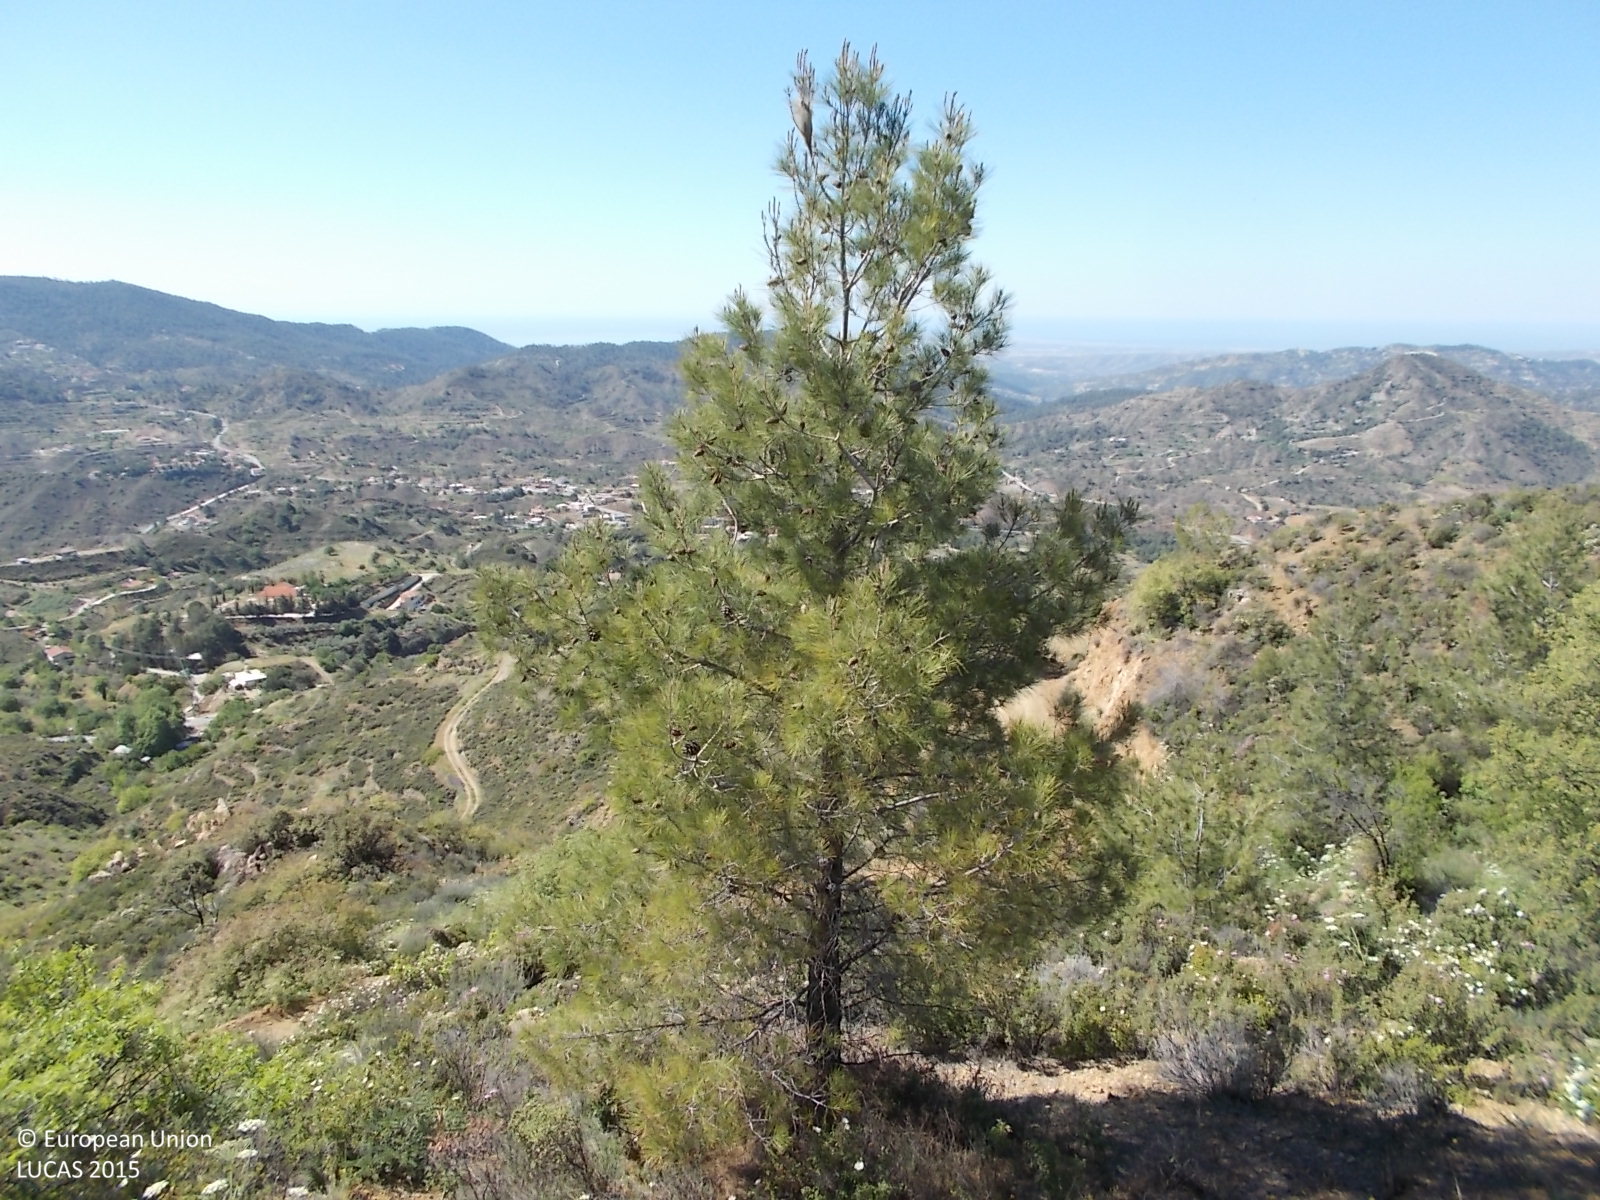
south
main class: Shrubland
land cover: Shrubland with sparse tree cover
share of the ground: > 75 %
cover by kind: shrubs 95 %, broadleaved forest trees 5 %
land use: Semi-natural and natural areas not in use
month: May
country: CY
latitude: 34.8636
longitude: 33.0209
